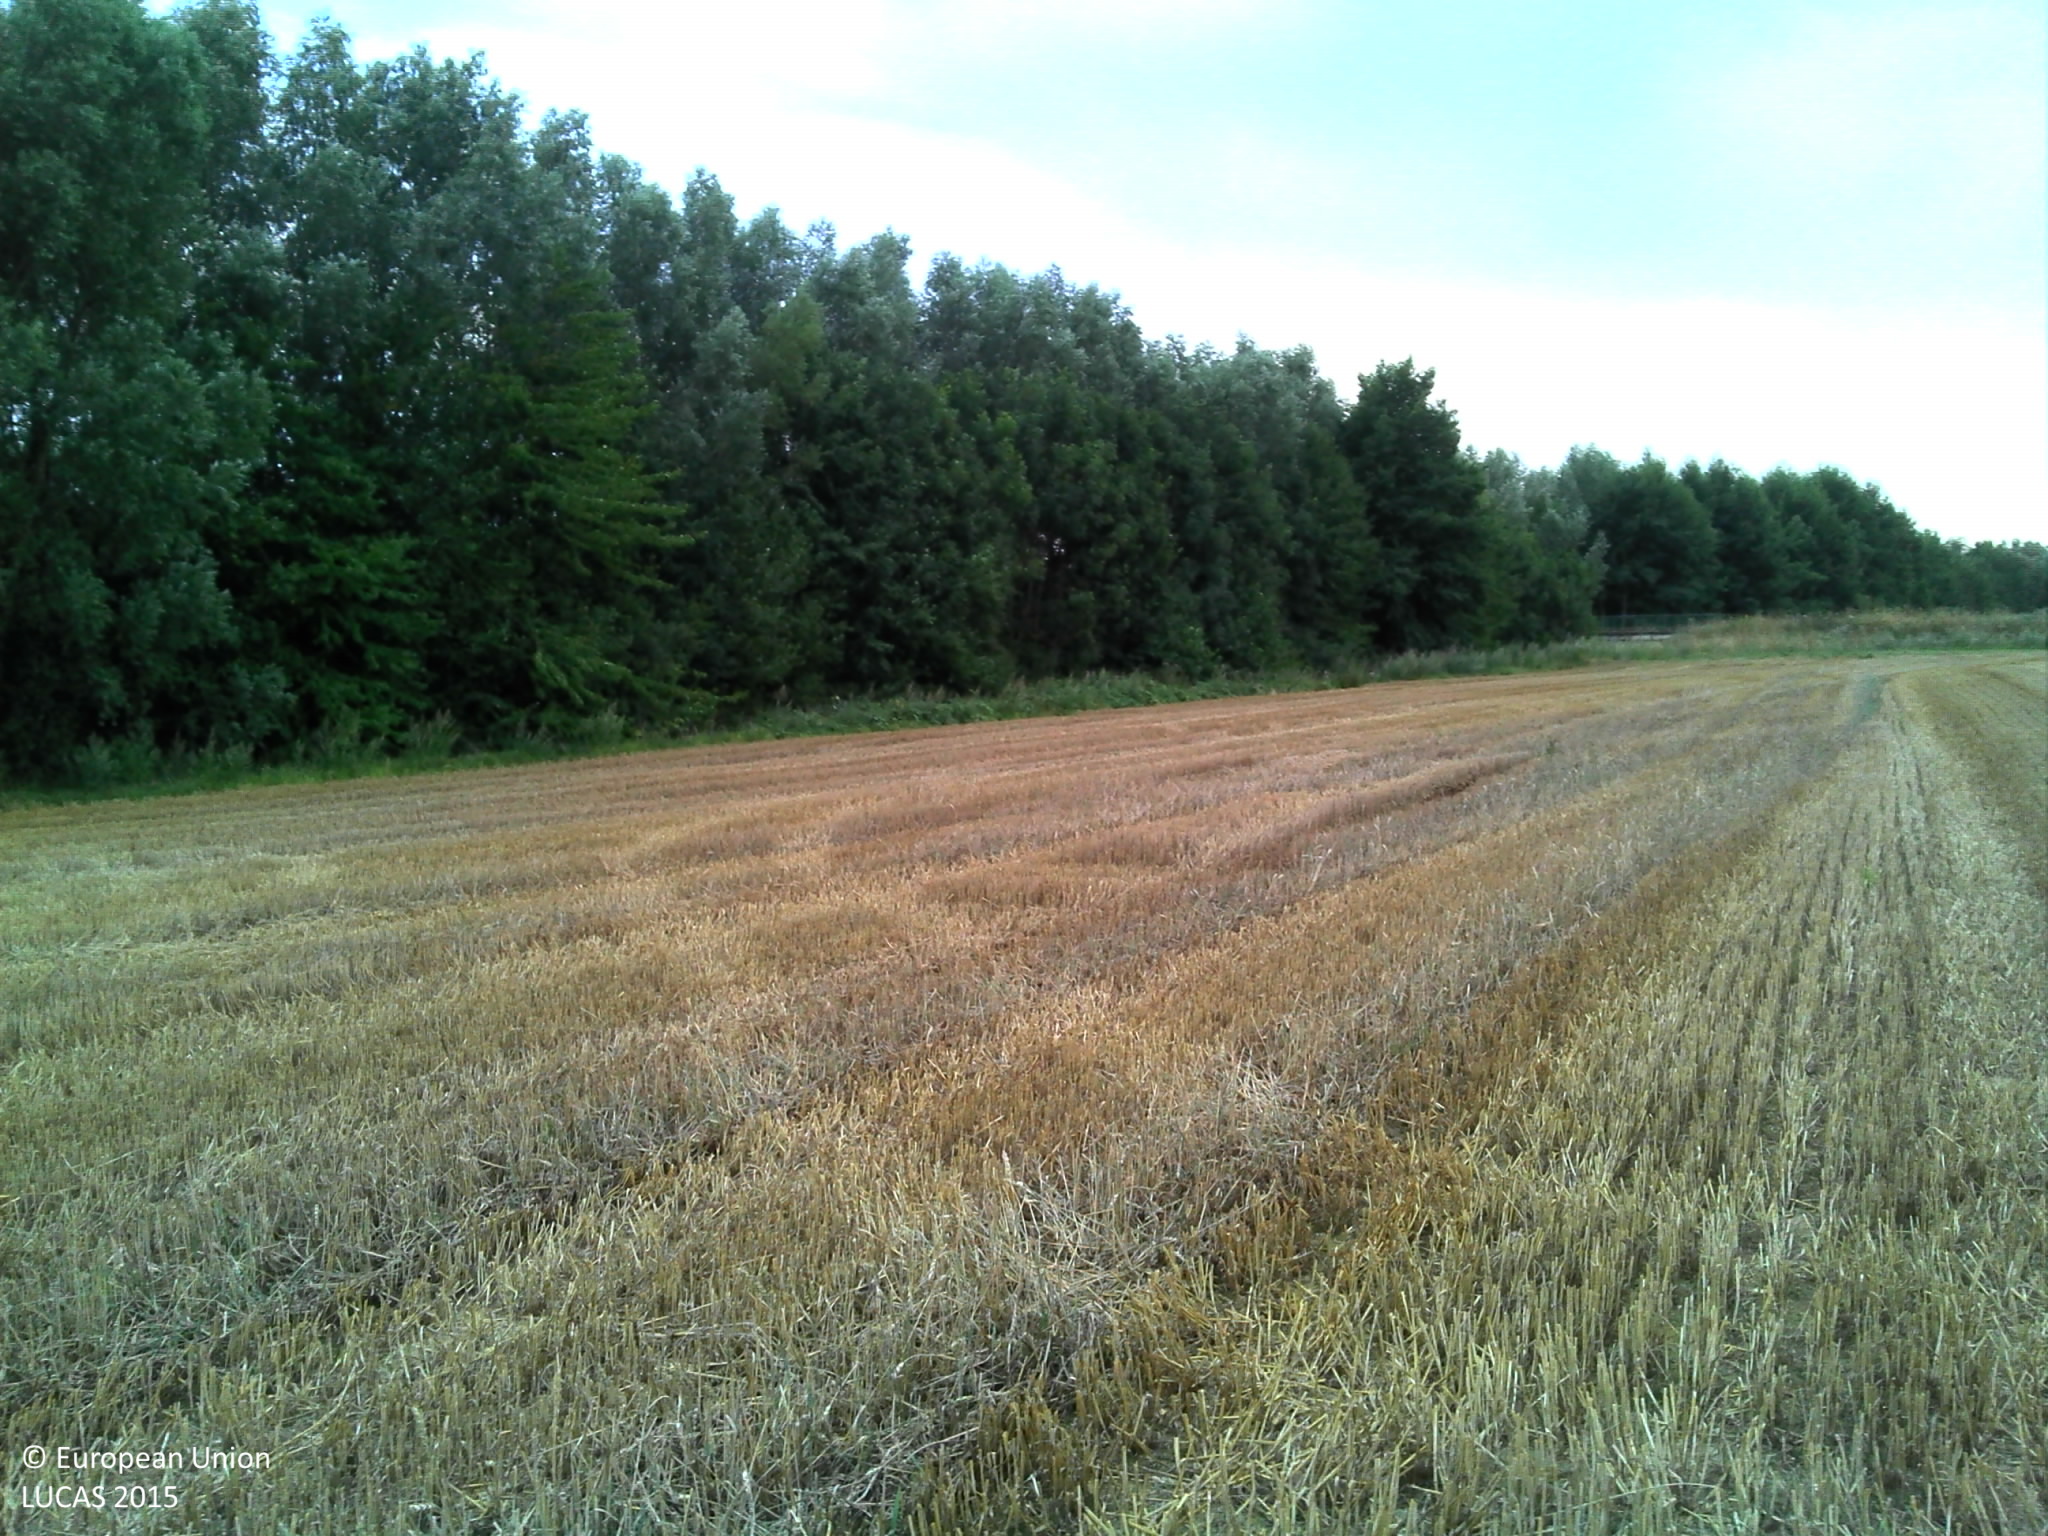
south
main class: Cropland
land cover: Common wheat
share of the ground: < 10 %
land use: Agriculture (excluding fallow land and kitchen gardens)
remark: Harvested field
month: August
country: BE
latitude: 50.6623
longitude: 3.7544
